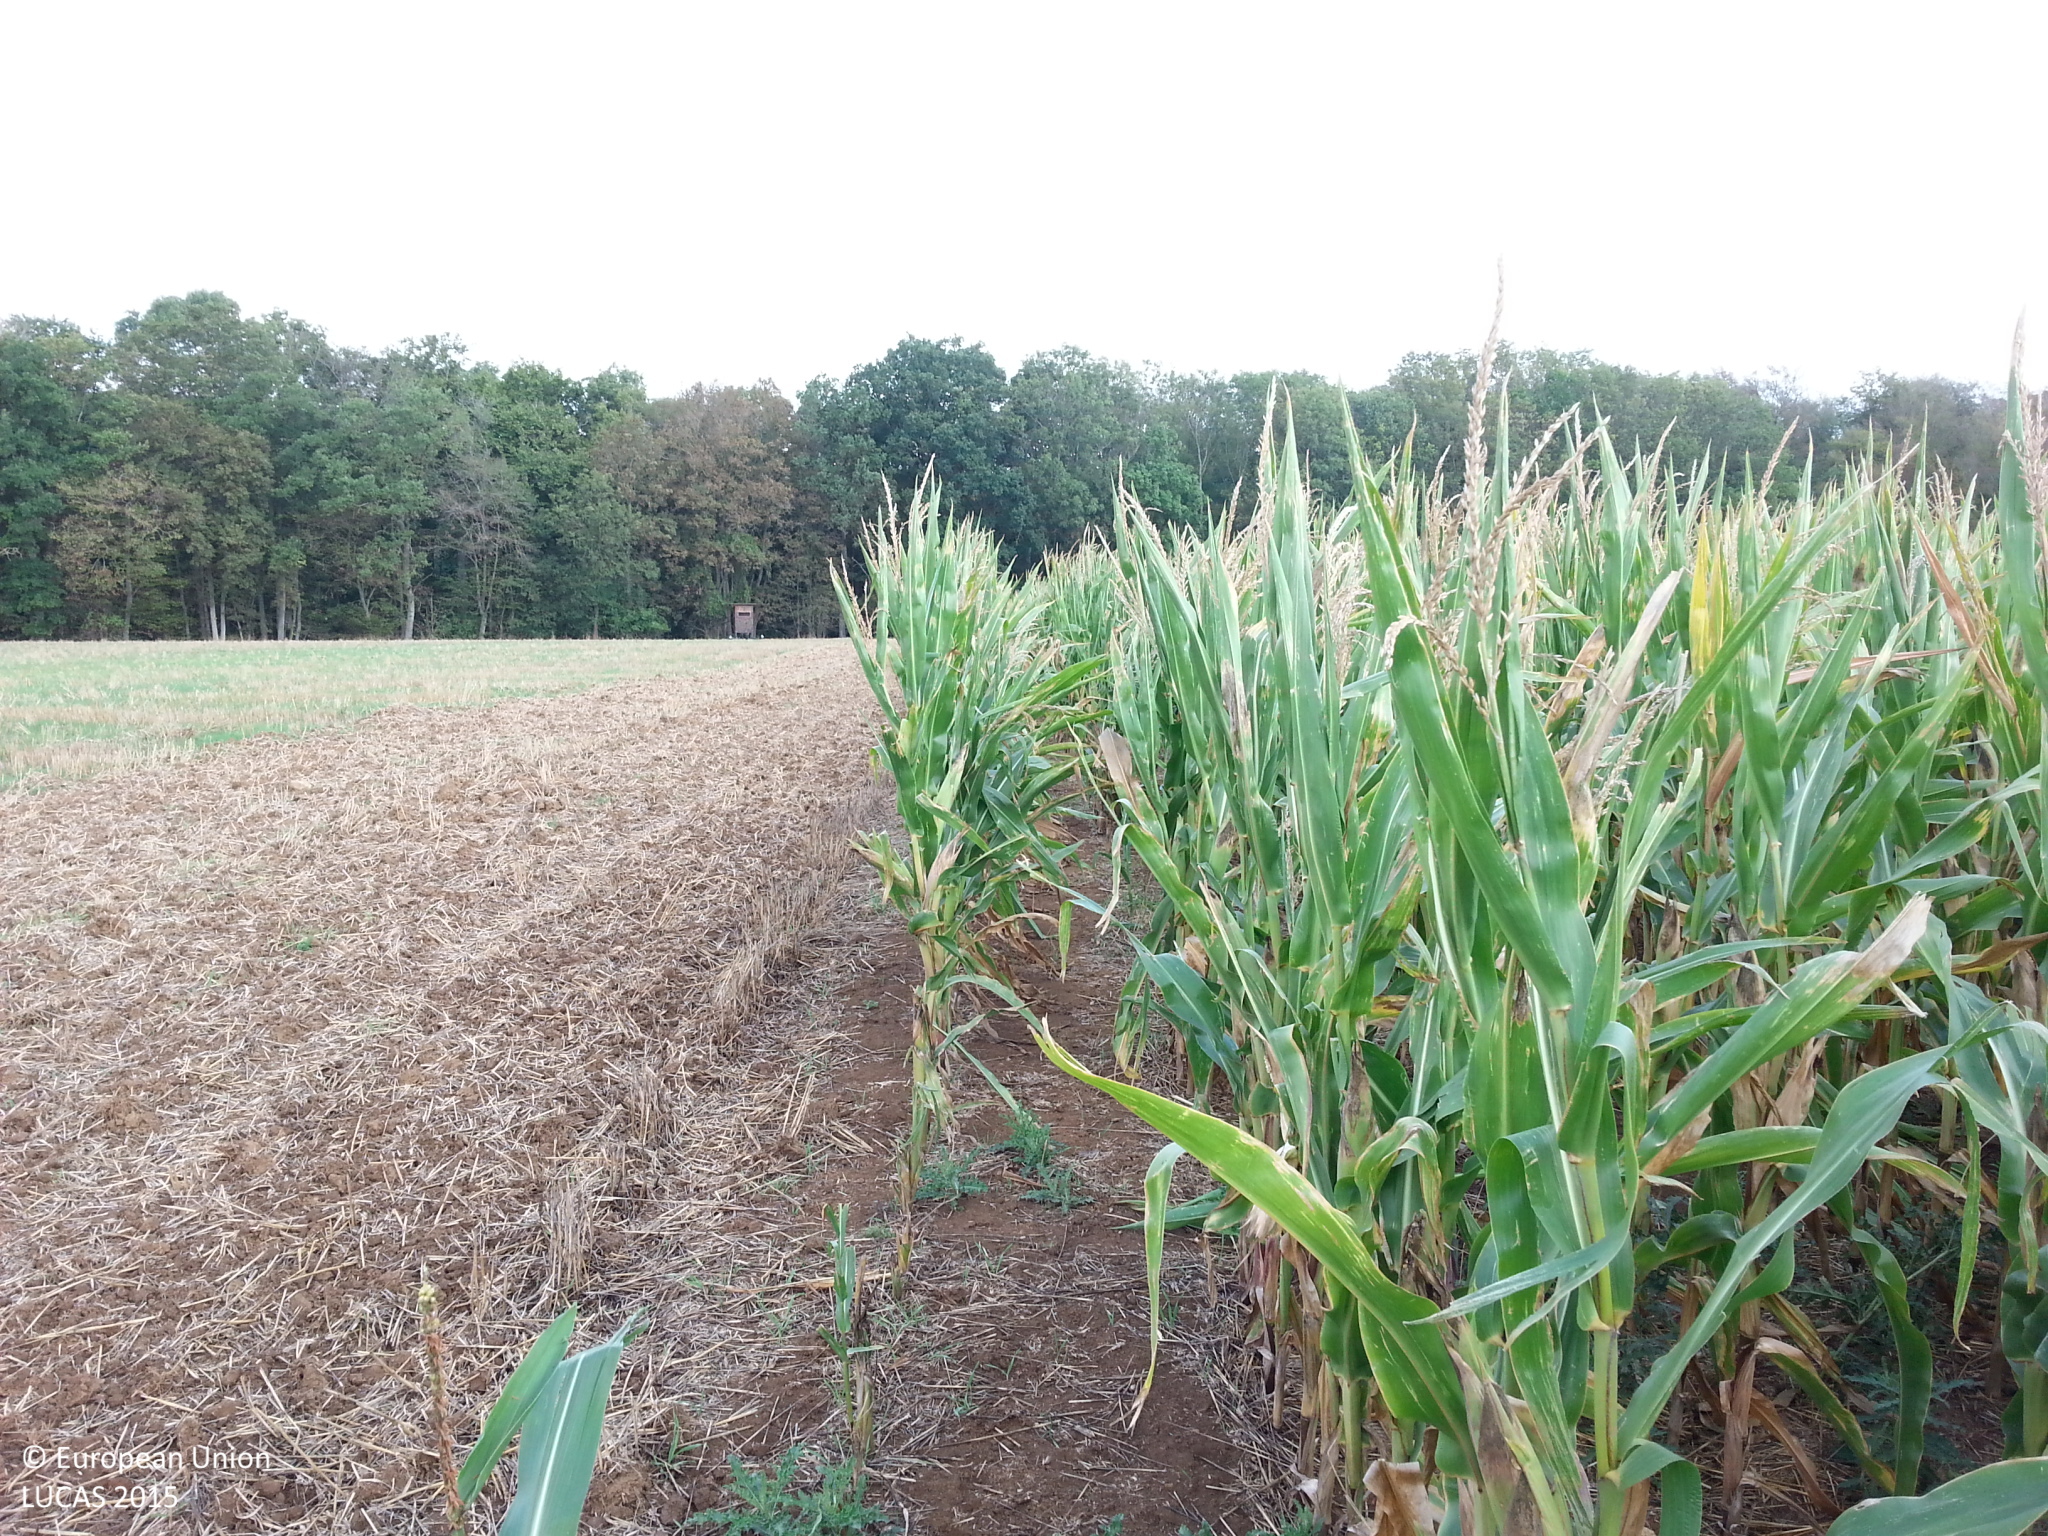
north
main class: Cropland
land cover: Maize
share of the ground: > 75 %
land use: Agriculture (excluding fallow land and kitchen gardens)
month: September
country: DE
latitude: 49.3569
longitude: 9.9587
